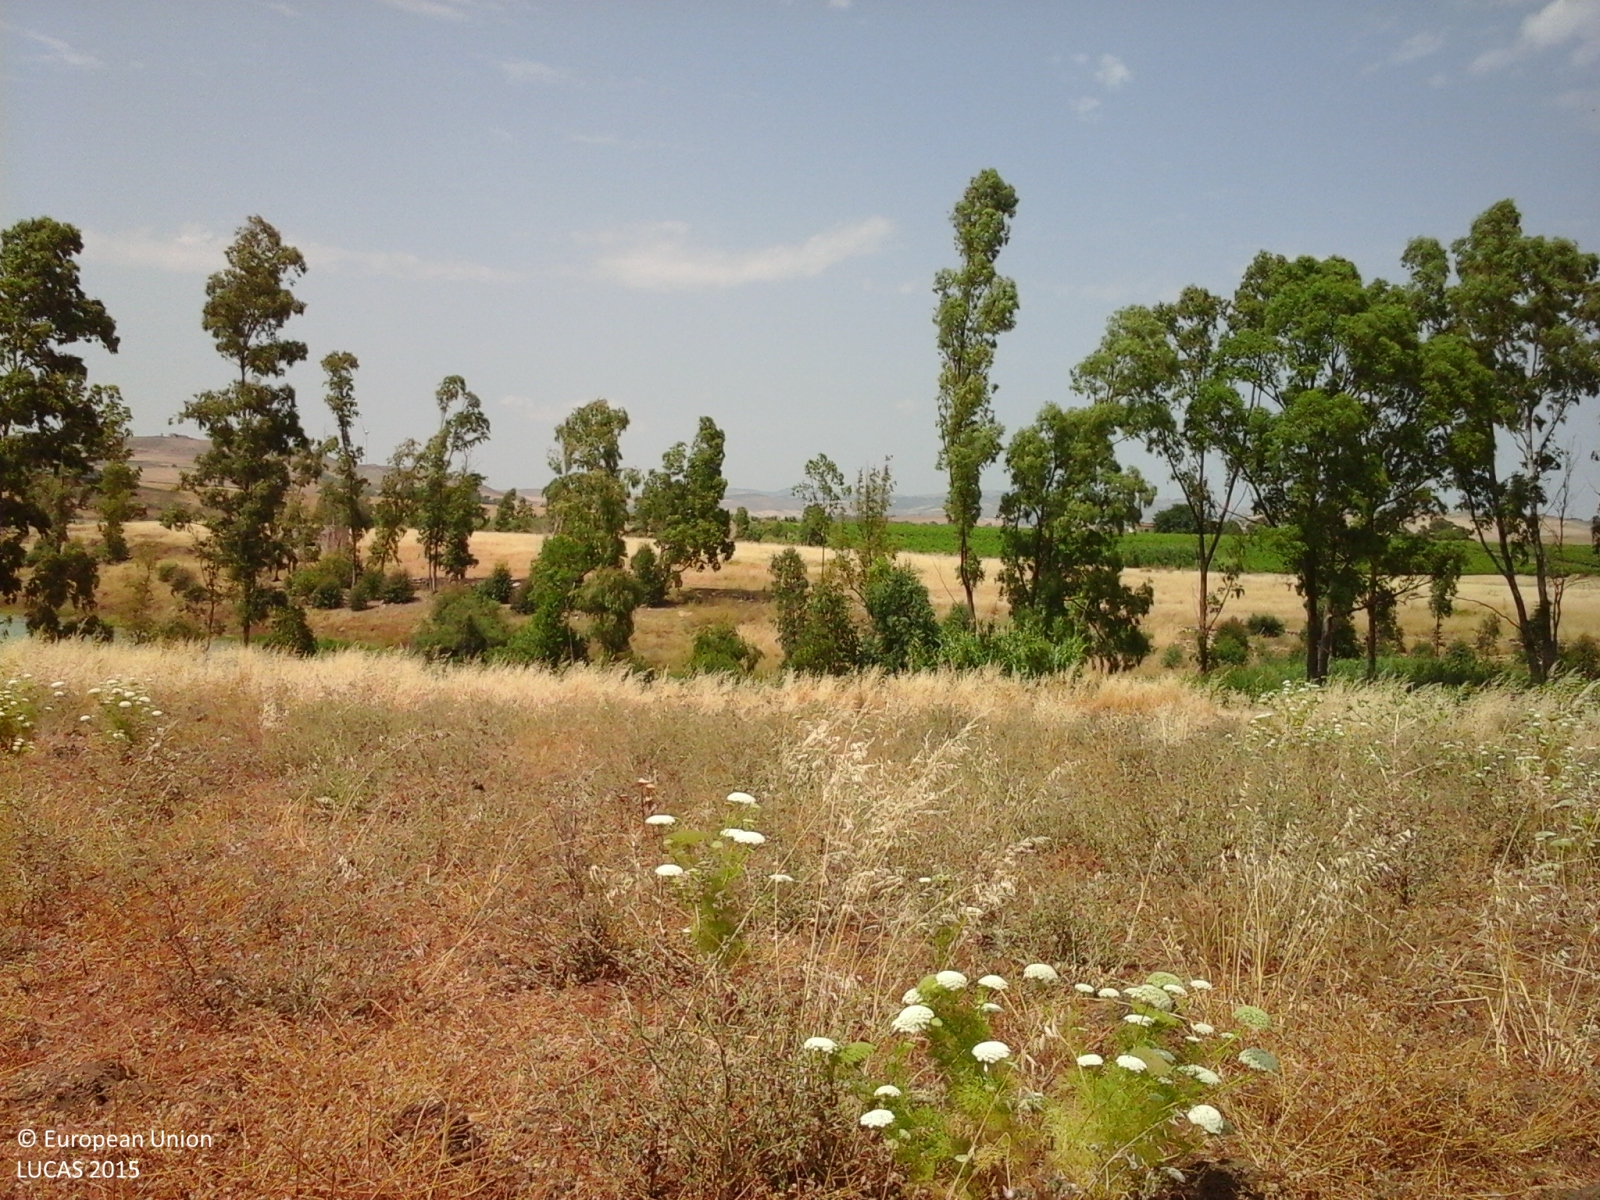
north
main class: Grassland
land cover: Spontaneously vegetated surfaces
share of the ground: > 75 %
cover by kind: herbaceous plants 100 %
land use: Fallow land
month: June
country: IT
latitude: 37.7076
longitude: 12.7583
